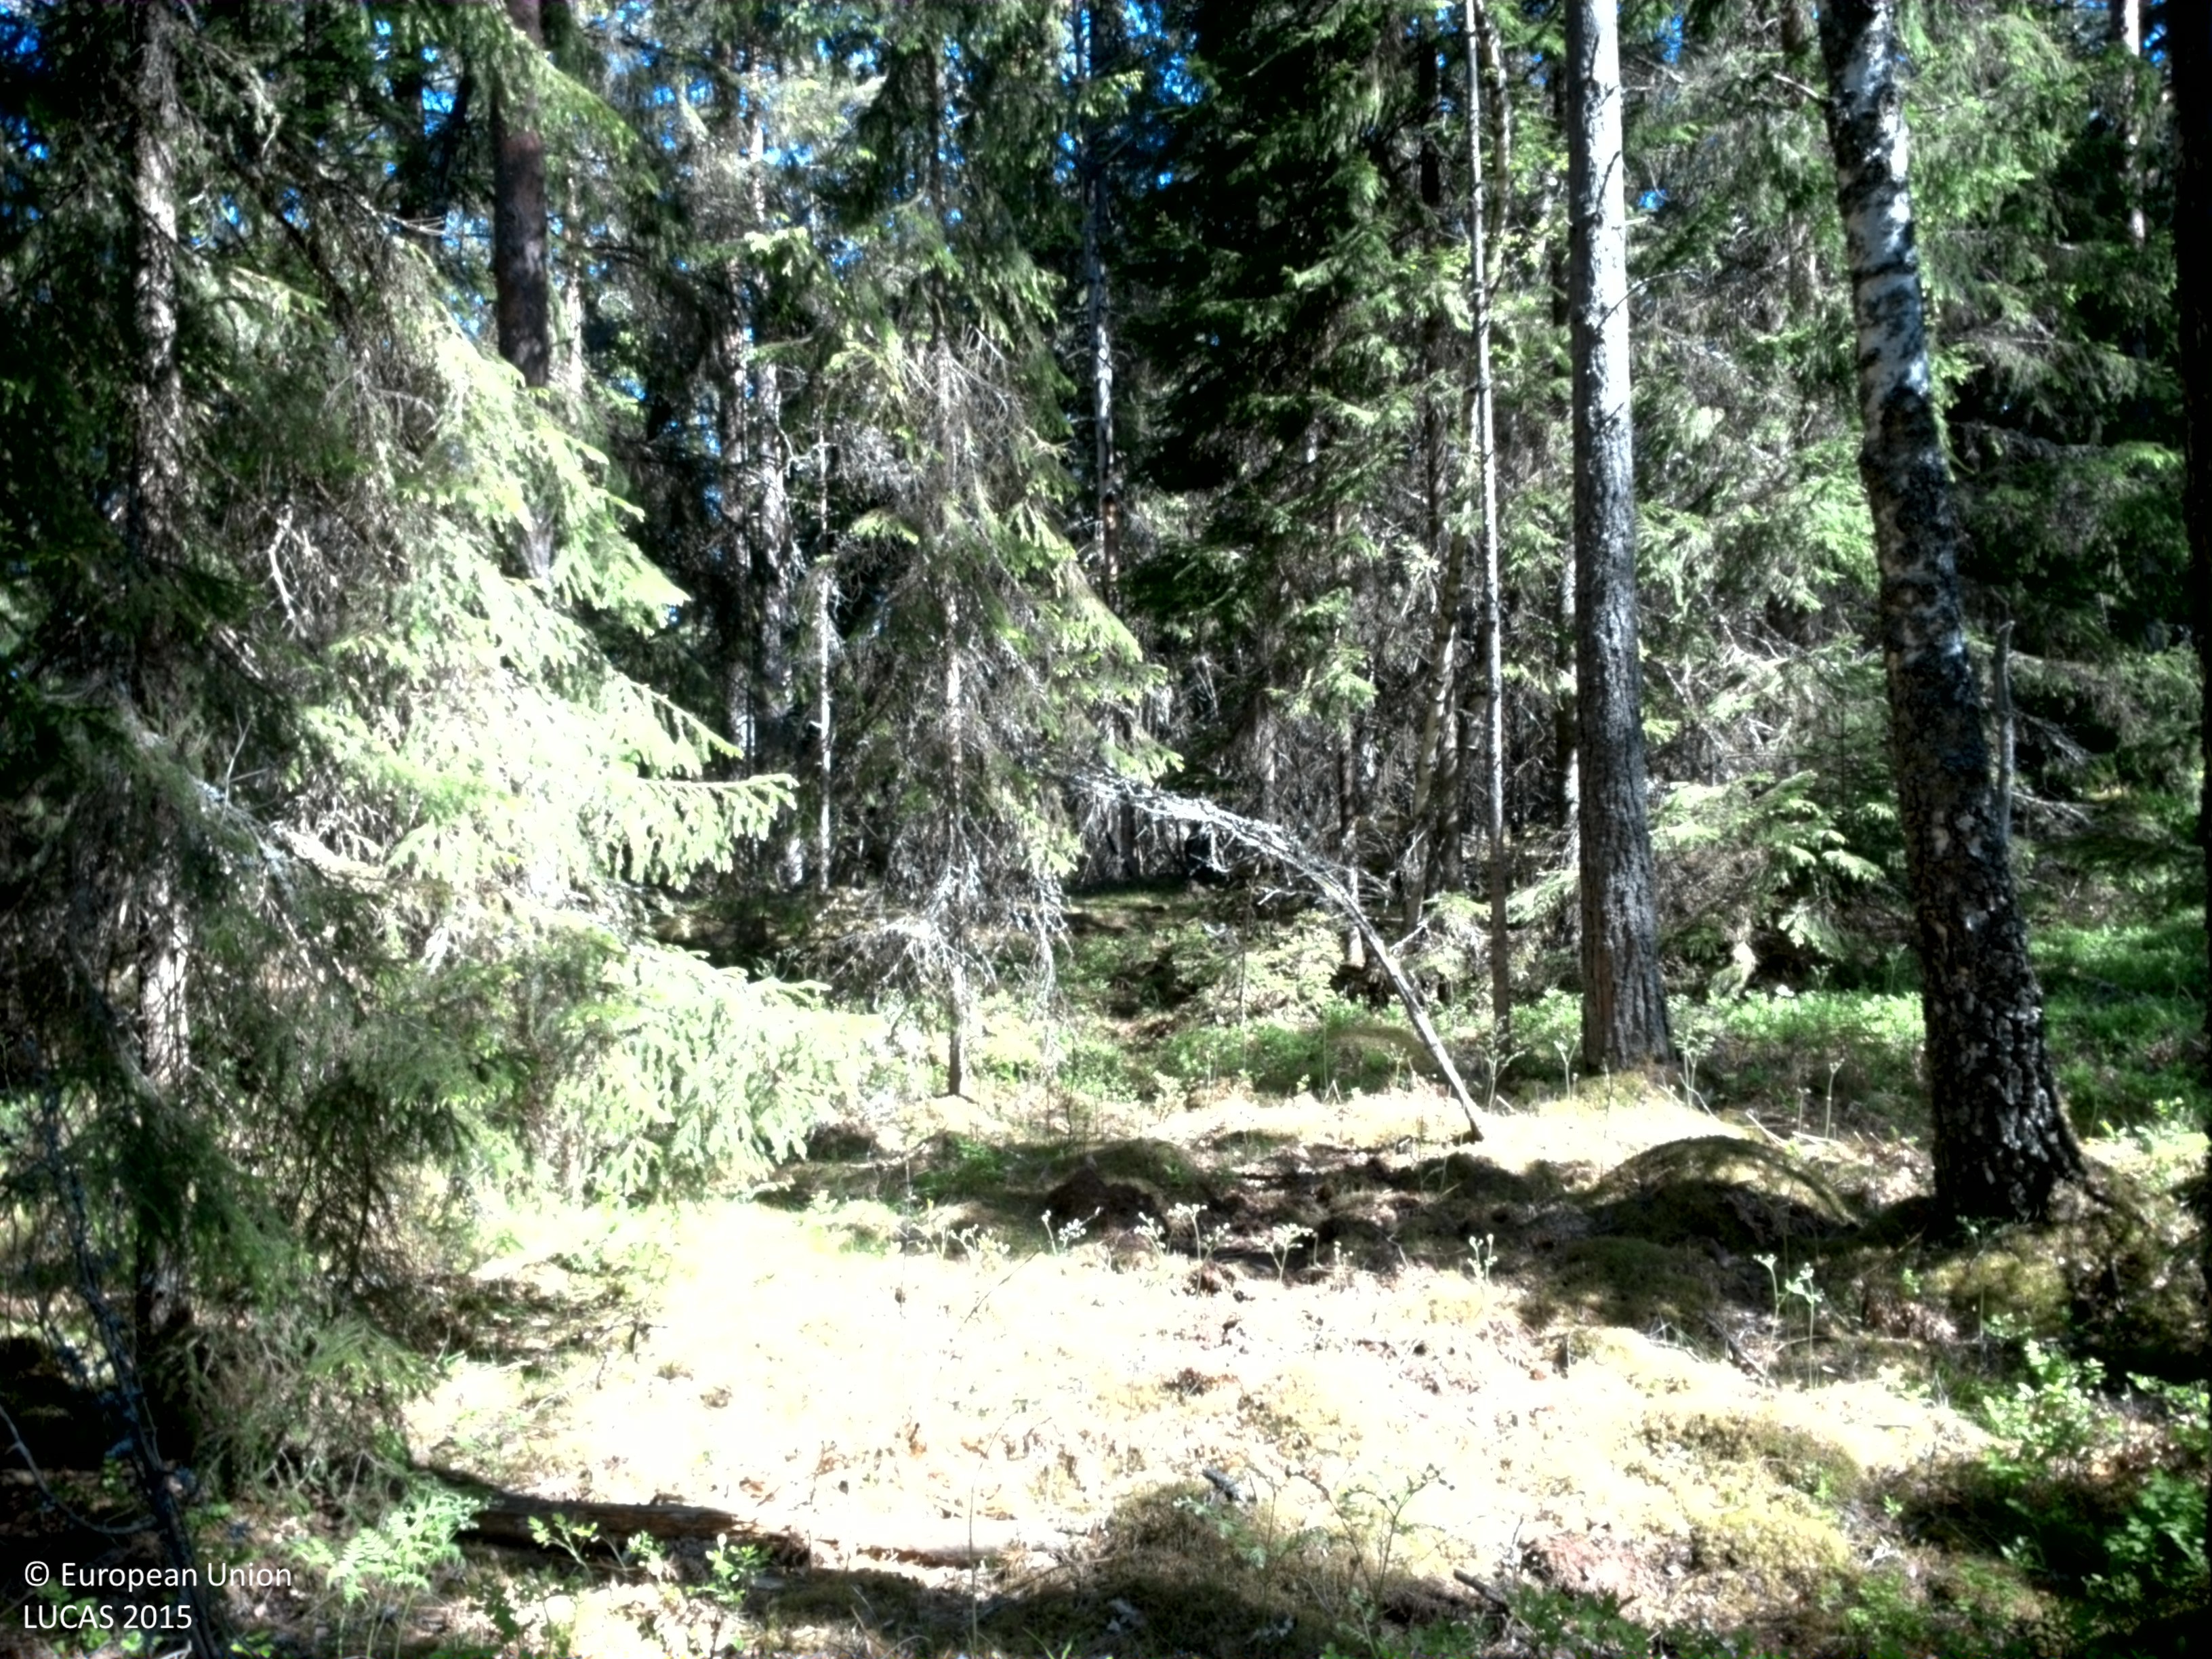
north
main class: Woodland
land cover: Pine dominated coniferous woodland
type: boreal forest
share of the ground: 50 - 75 %
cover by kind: coniferous forest trees 50 %, broadleaved forest trees 15 %, lichens and mosses 15 %, shrubs 10 %, herbaceous plants 10 %
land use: Forestry
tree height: > 5 m
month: May
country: SE
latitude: 57.3819
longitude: 16.0028
